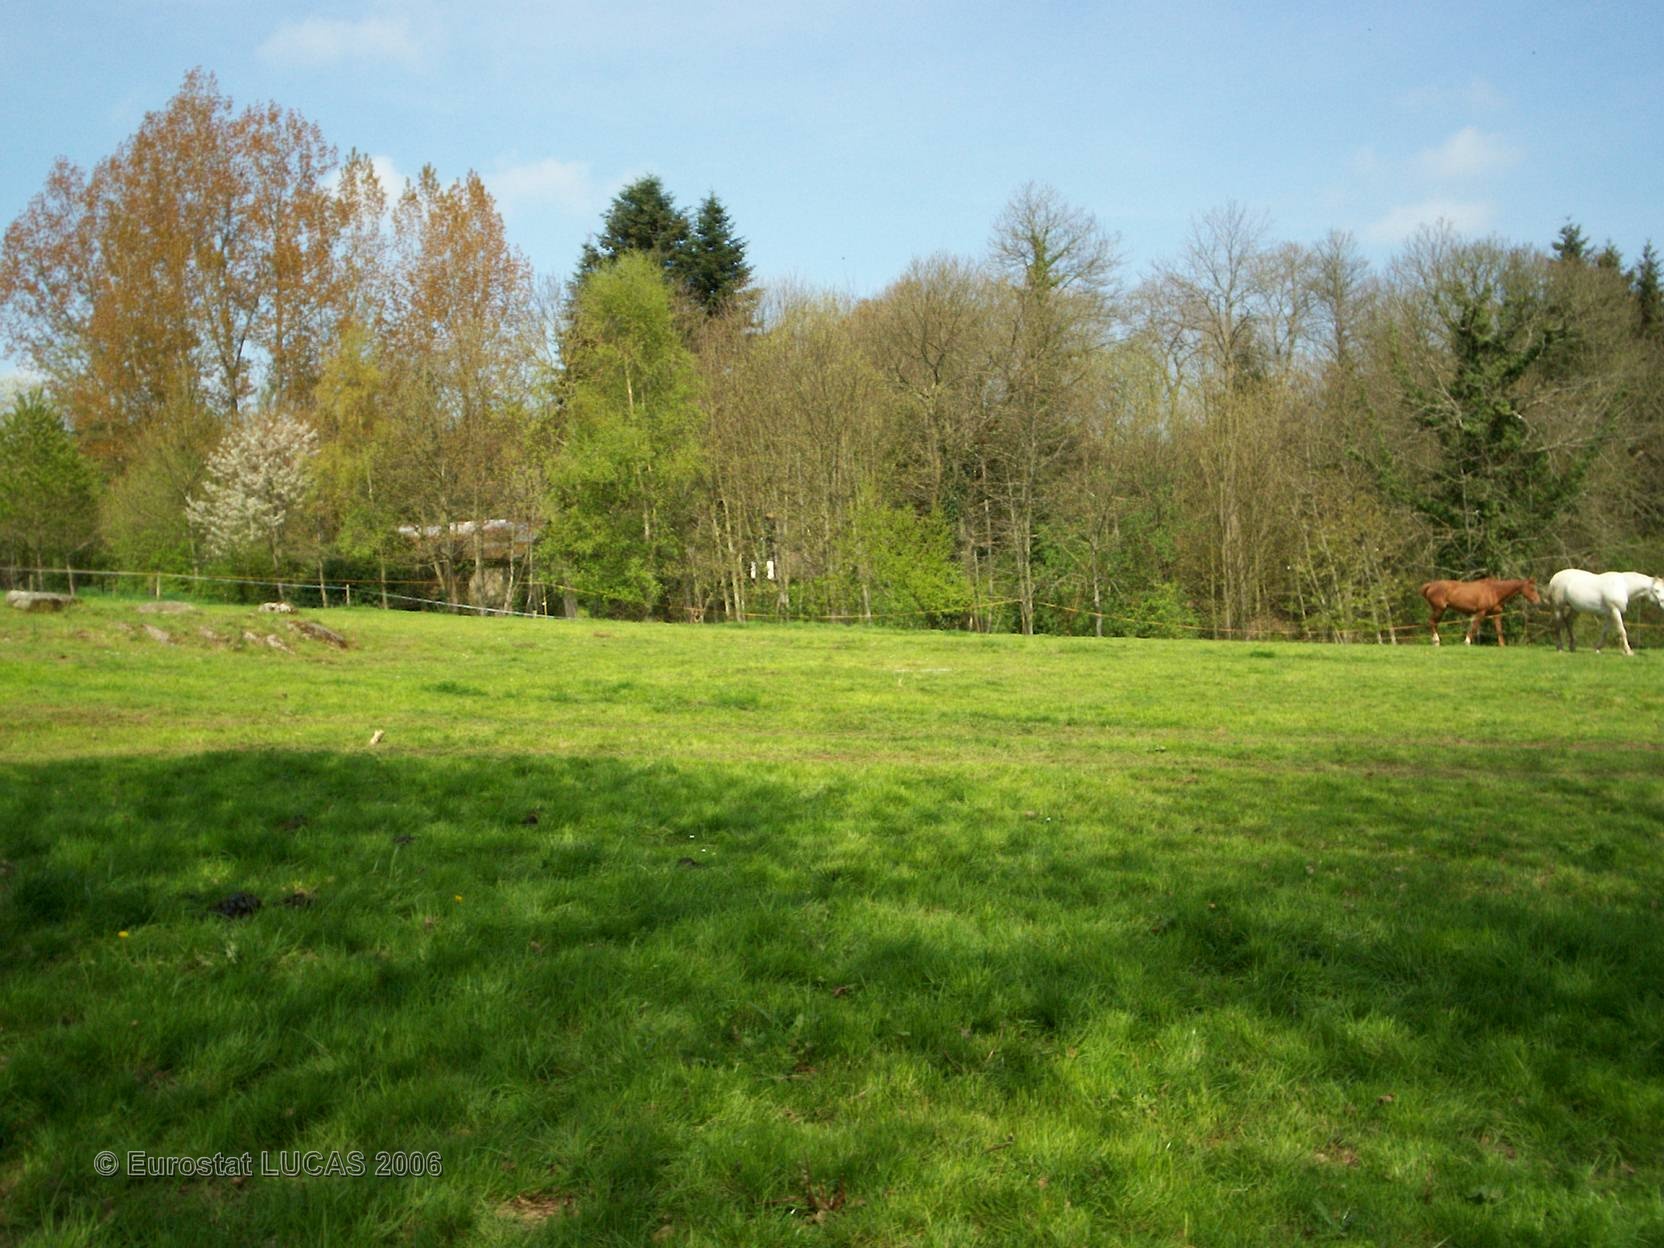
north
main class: Grassland
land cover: Grassland without tree/shrub cover
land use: Agriculture (excluding fallow land and kitchen gardens)
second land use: Sport
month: May
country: FR
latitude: 48.2768
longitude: -2.4705
